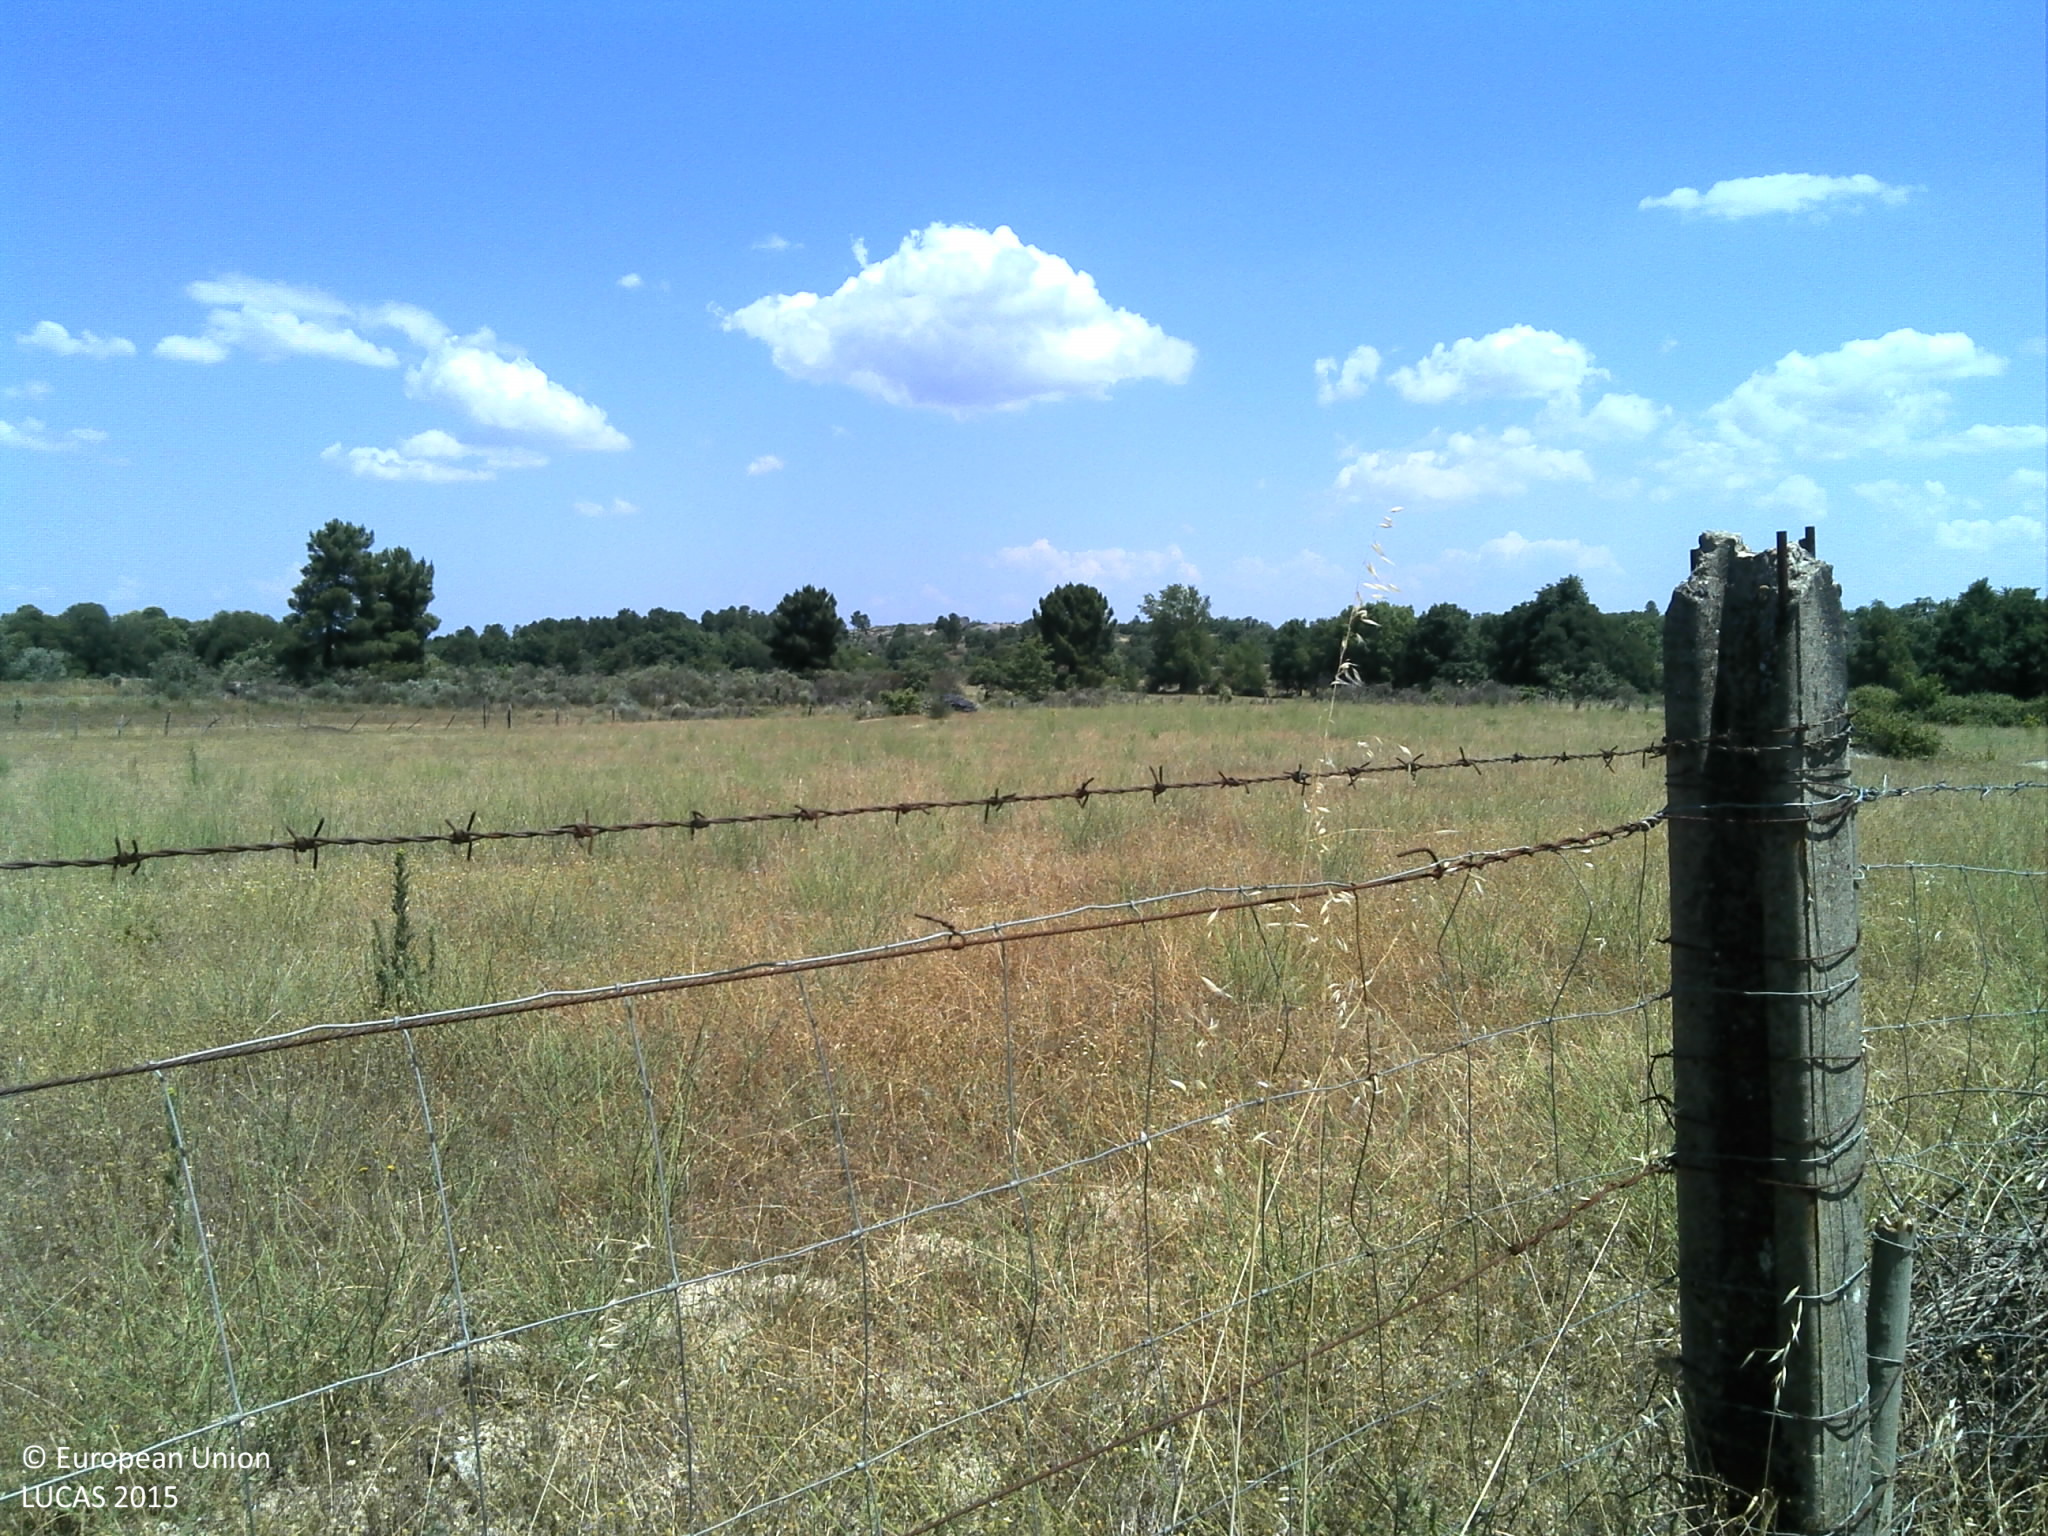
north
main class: Grassland
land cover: Grassland without tree/shrub cover
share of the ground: > 75 %
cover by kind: herbaceous plants 80 %, unconsolidated bare surface 20 %
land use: Agriculture (excluding fallow land and kitchen gardens)
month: June
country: PT
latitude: 40.7327
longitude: -7.1692
